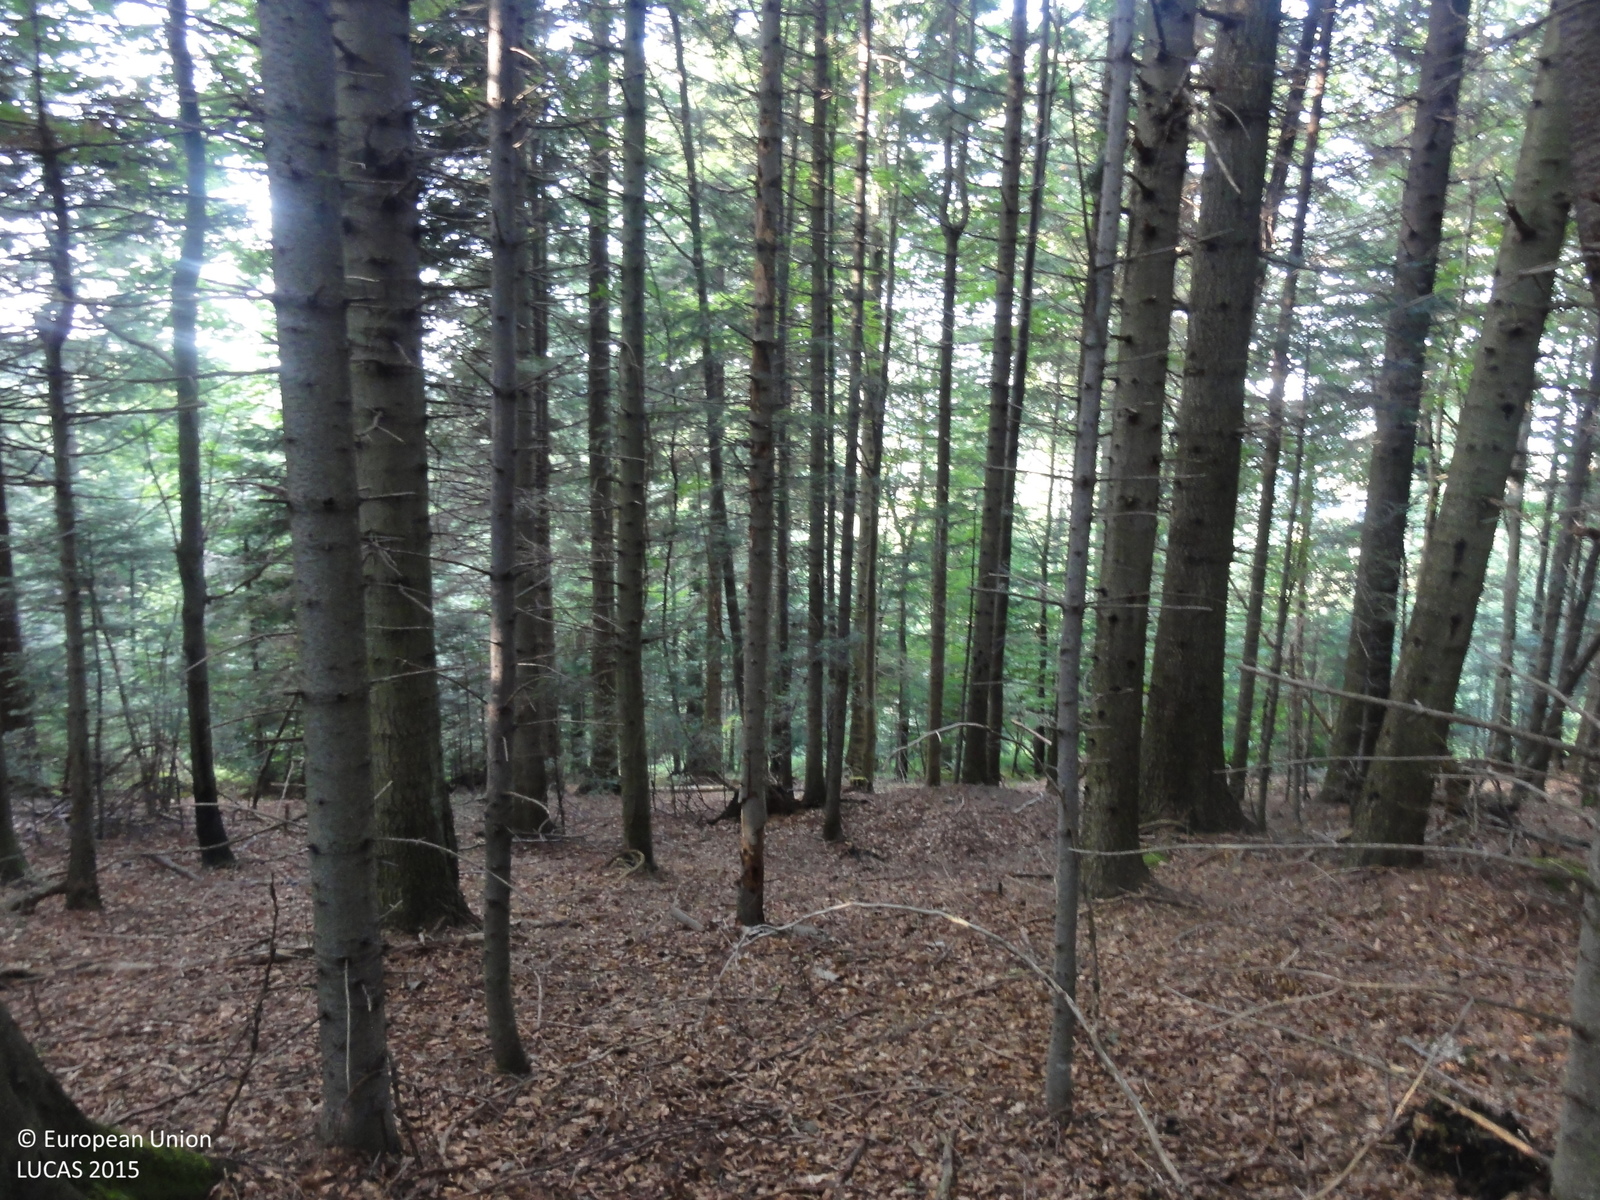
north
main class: Woodland
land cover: Spruce dominated mixed woodland
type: mountainous beech forest
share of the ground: > 75 %
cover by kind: coniferous forest trees 70 %, broadleaved forest trees 30 %
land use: Forestry
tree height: > 5 m
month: August
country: SI
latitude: 46.0657
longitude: 15.4919
